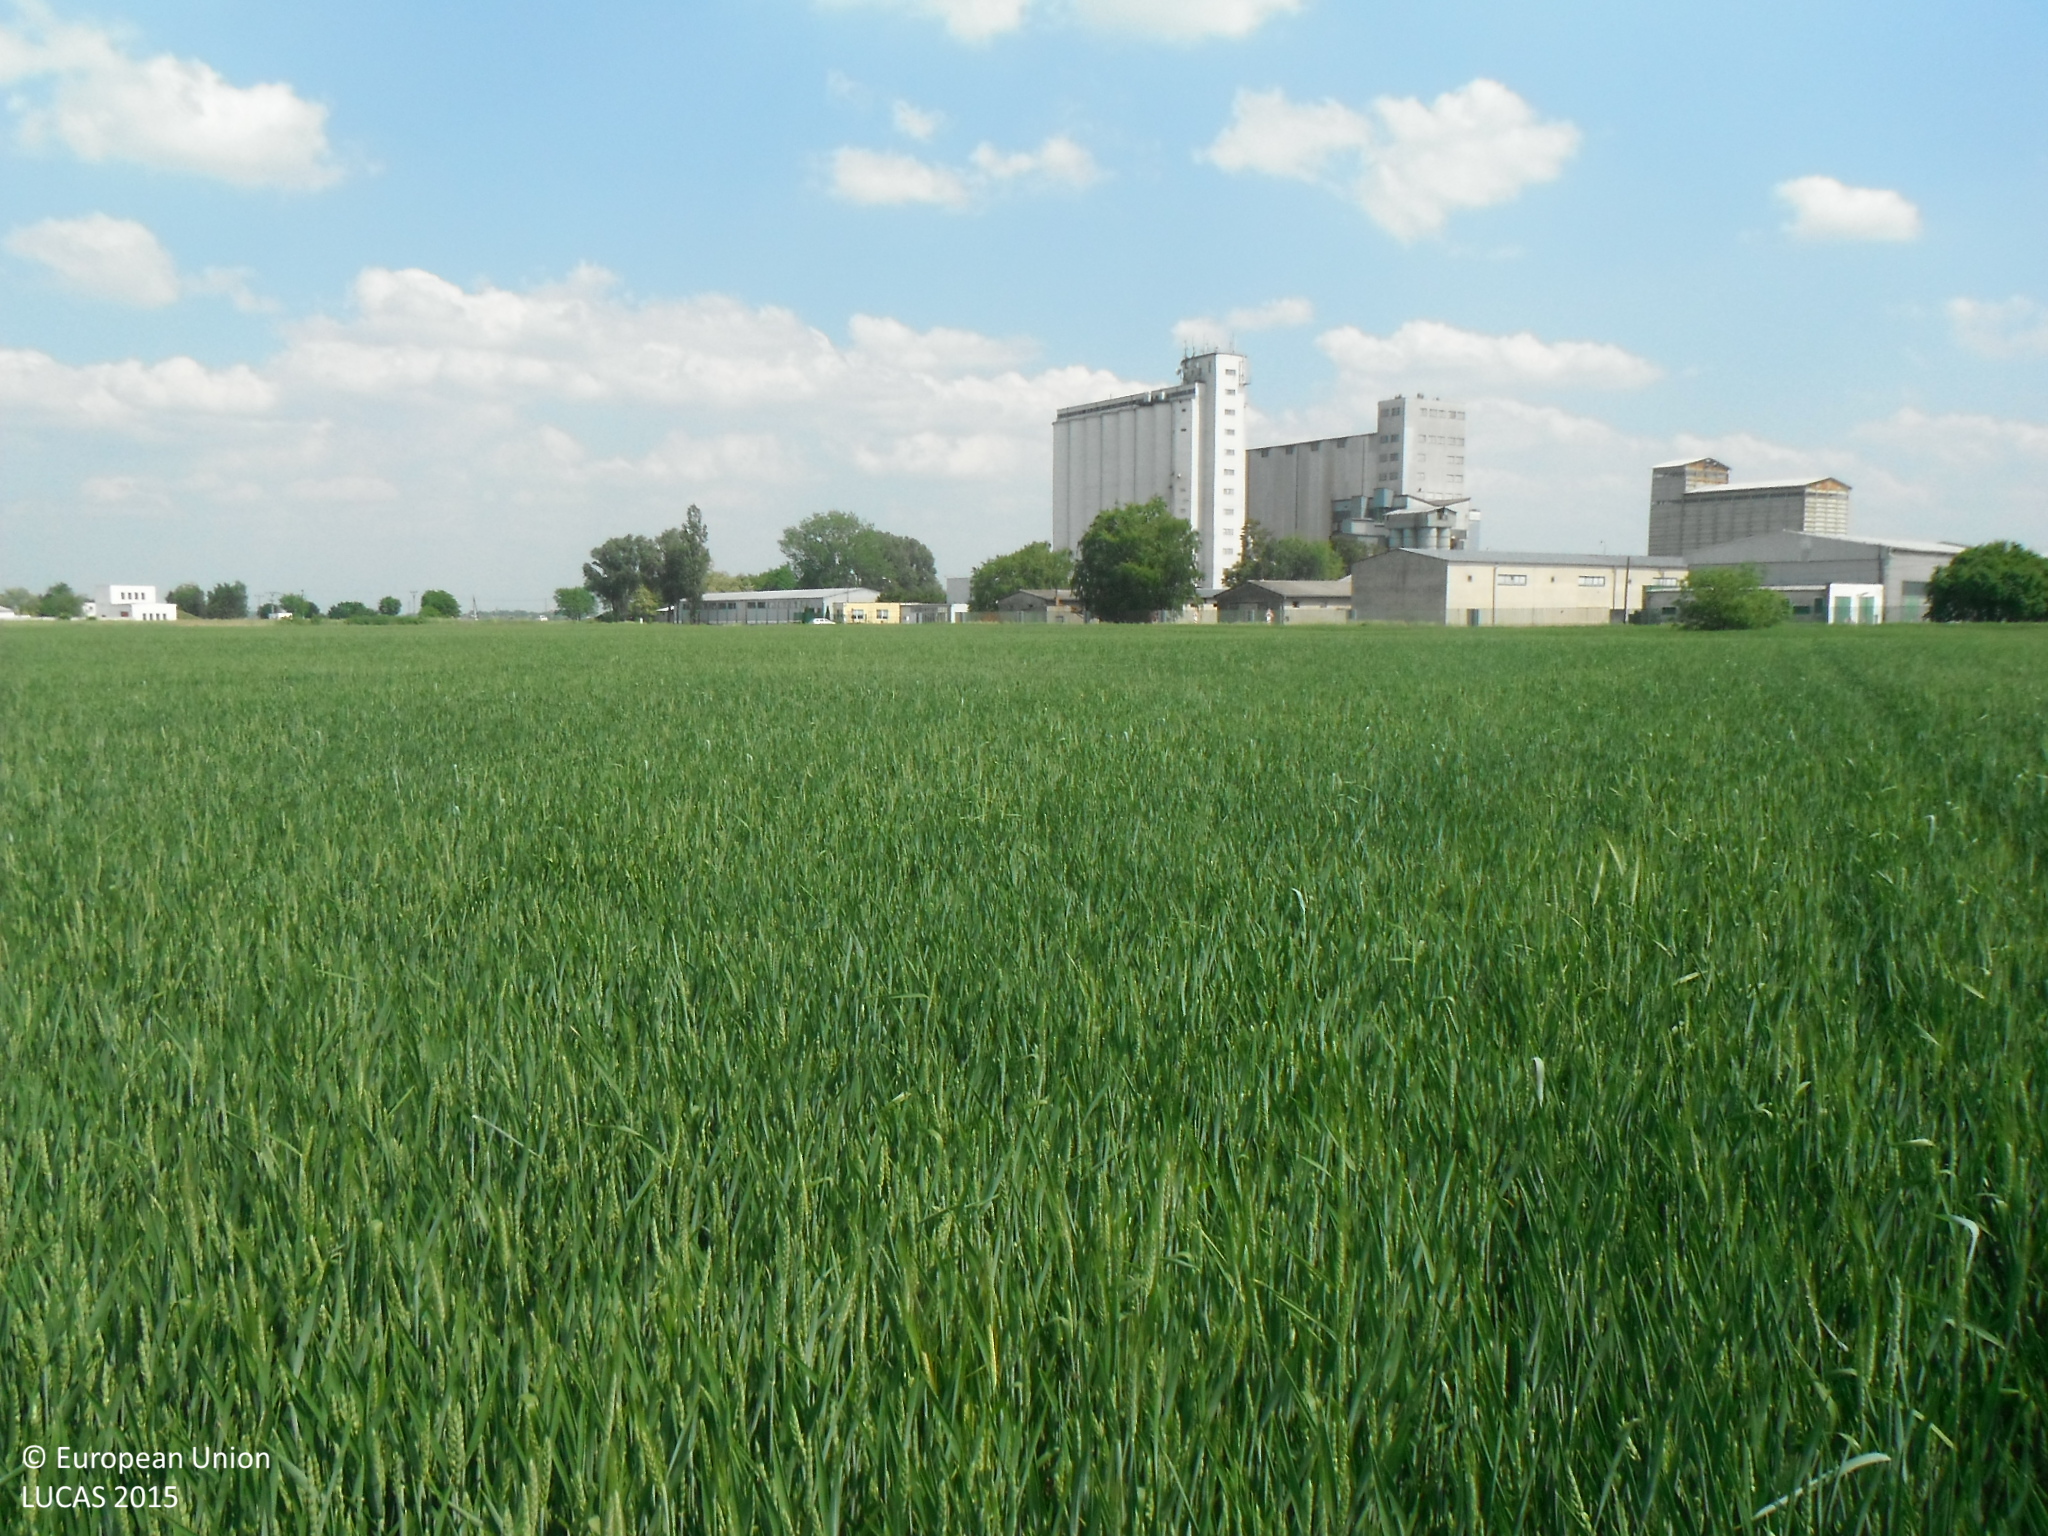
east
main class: Cropland
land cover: Common wheat
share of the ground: > 75 %
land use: Agriculture (excluding fallow land and kitchen gardens)
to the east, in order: Common wheat; Grass margins; Artificial constructions in urban areas
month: May
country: SK
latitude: 47.9514
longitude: 17.7367
